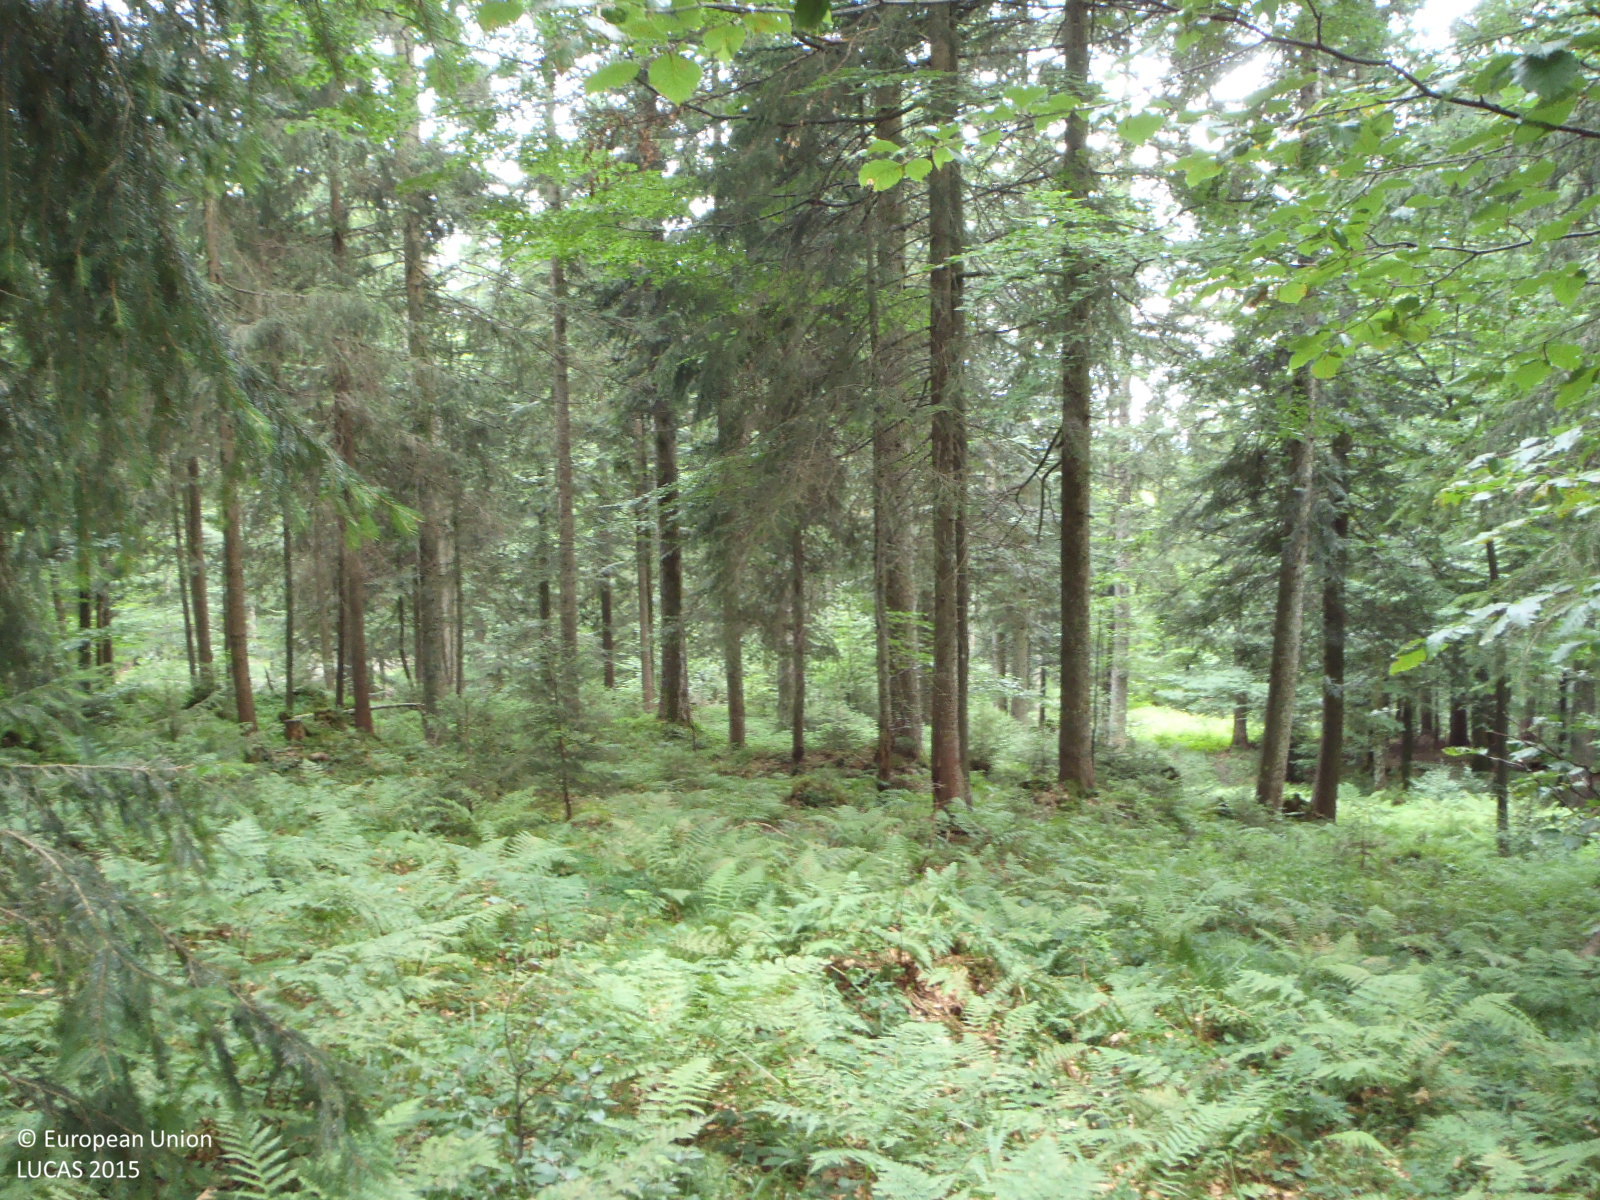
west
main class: Woodland
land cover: Spruce dominated mixed woodland
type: alpine coniferous forest
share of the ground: > 75 %
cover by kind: coniferous forest trees 55 %, broadleaved forest trees 30 %, herbaceous plants 10 %, unconsolidated bare surface 5 %
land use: Forestry
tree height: > 5 m
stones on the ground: < 10 %
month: July
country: AT
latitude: 47.5036
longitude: 9.9867
